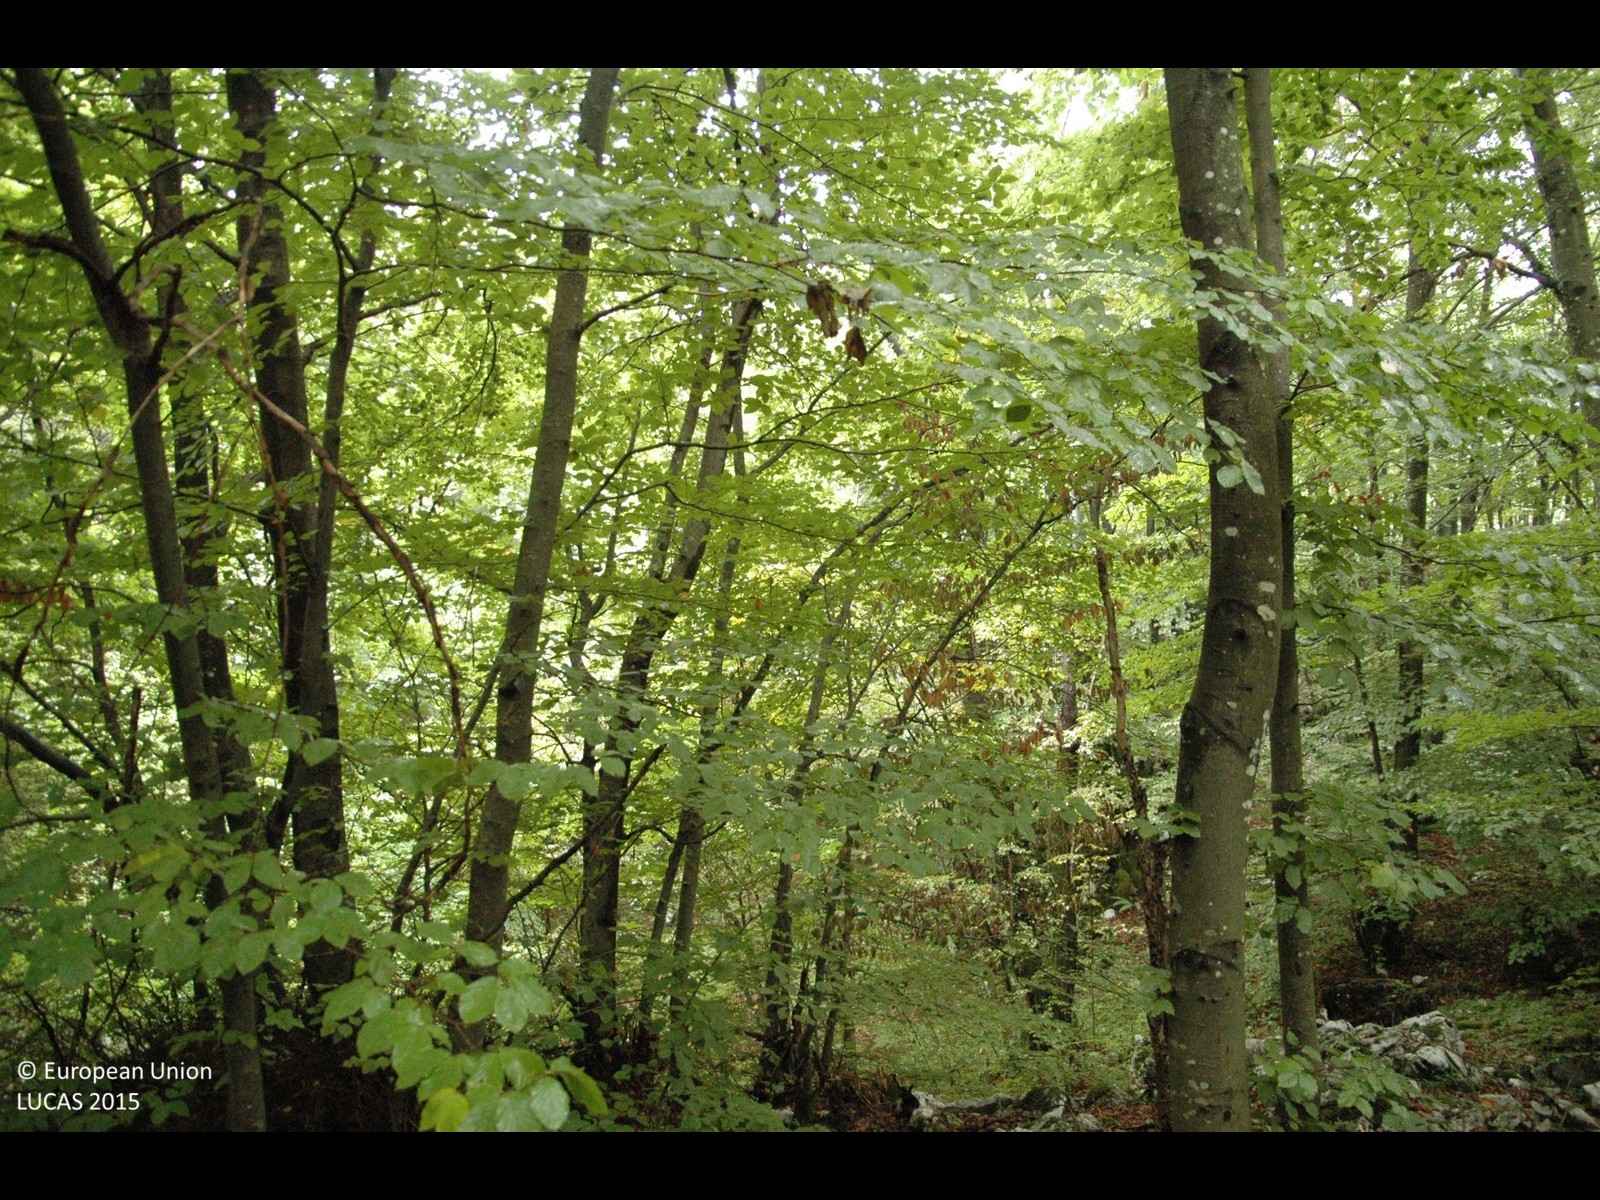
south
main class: Woodland
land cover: Broadleaved woodland
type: beech forest
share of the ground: > 75 %
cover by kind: broadleaved forest trees 100 %
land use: Forestry
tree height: > 5 m
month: October
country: HR
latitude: 45.1392
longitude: 15.2469
